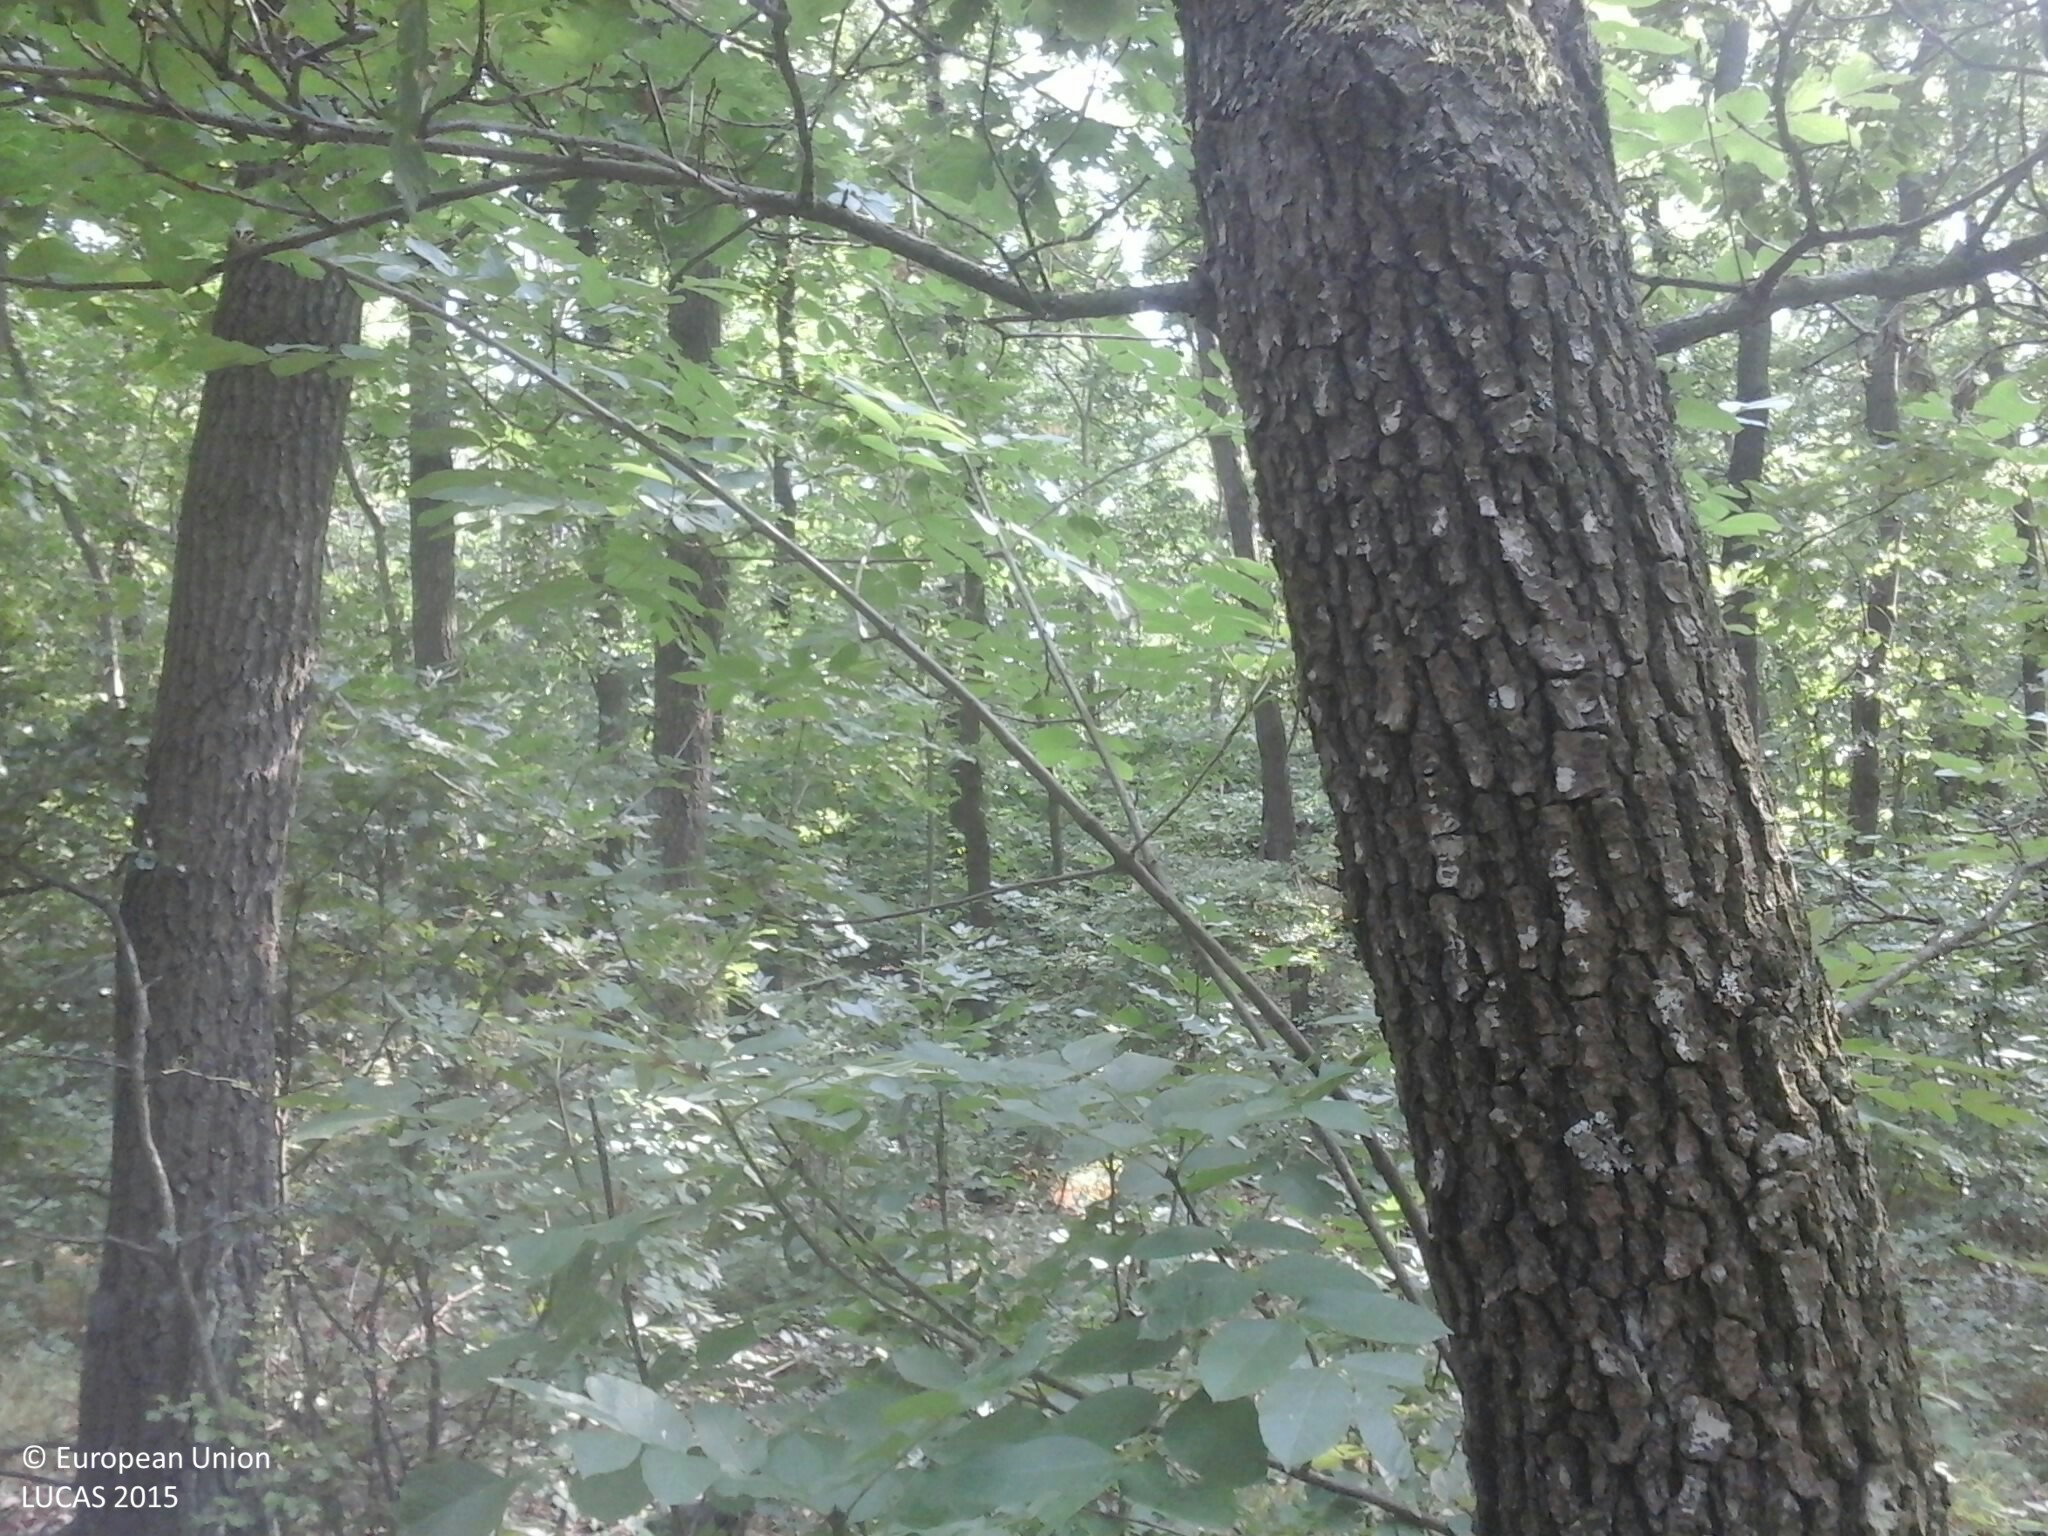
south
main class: Woodland
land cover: Broadleaved woodland
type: acidophilous oak and oak-birch forest
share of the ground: > 75 %
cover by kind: broadleaved forest trees 95 %, shrubs 5 %
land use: Forestry
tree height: > 5 m
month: July
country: HU
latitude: 46.9186
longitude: 17.7682
